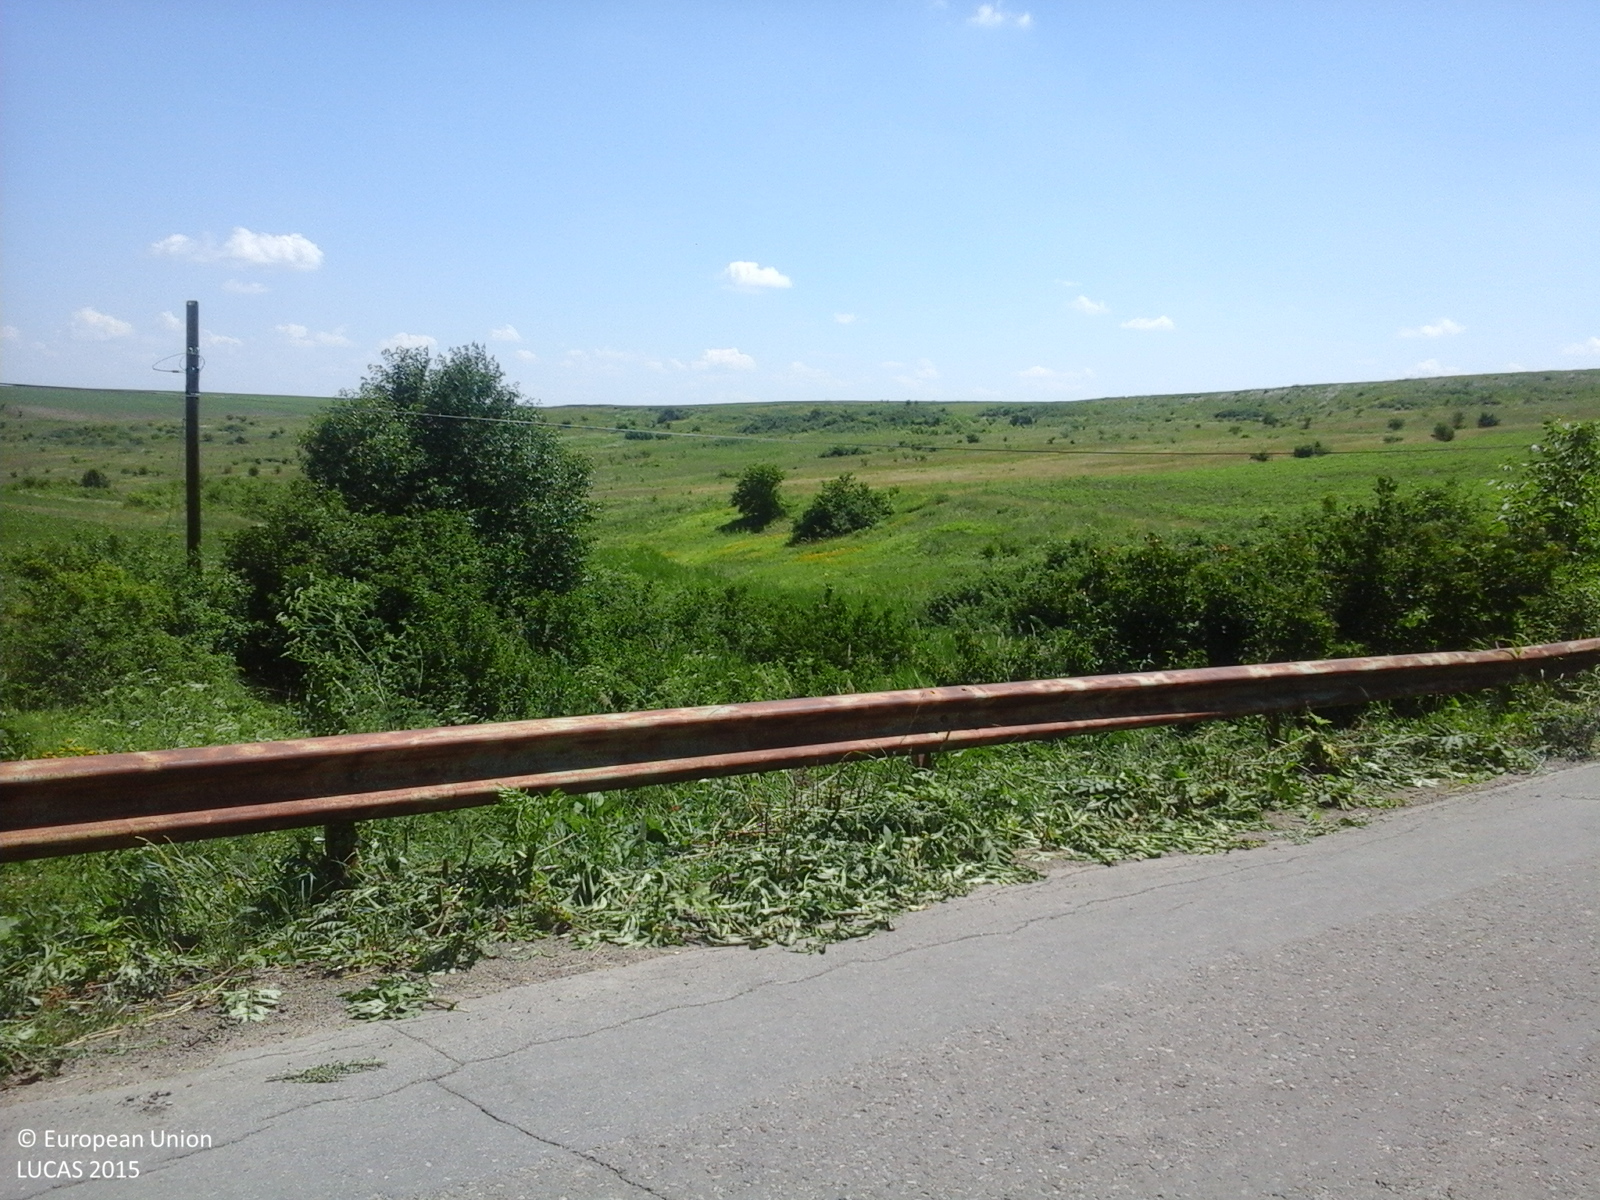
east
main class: Shrubland
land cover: Shrubland with sparse tree cover
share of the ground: > 75 %
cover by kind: shrubs 95 %, broadleaved forest trees 5 %
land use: Abandoned areas
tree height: > 5 m
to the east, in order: Shrubland with sparse tree cover; Paved roads, cycling and walking lanes; Shrubland without tree cover; Electric lines; Inland marshes; Spontaneously vegetated surfaces; Shrubland with sparse tree cover; Tracks; Grassland without tree/shrub cover
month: June
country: RO
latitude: 47.7975
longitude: 27.0760
